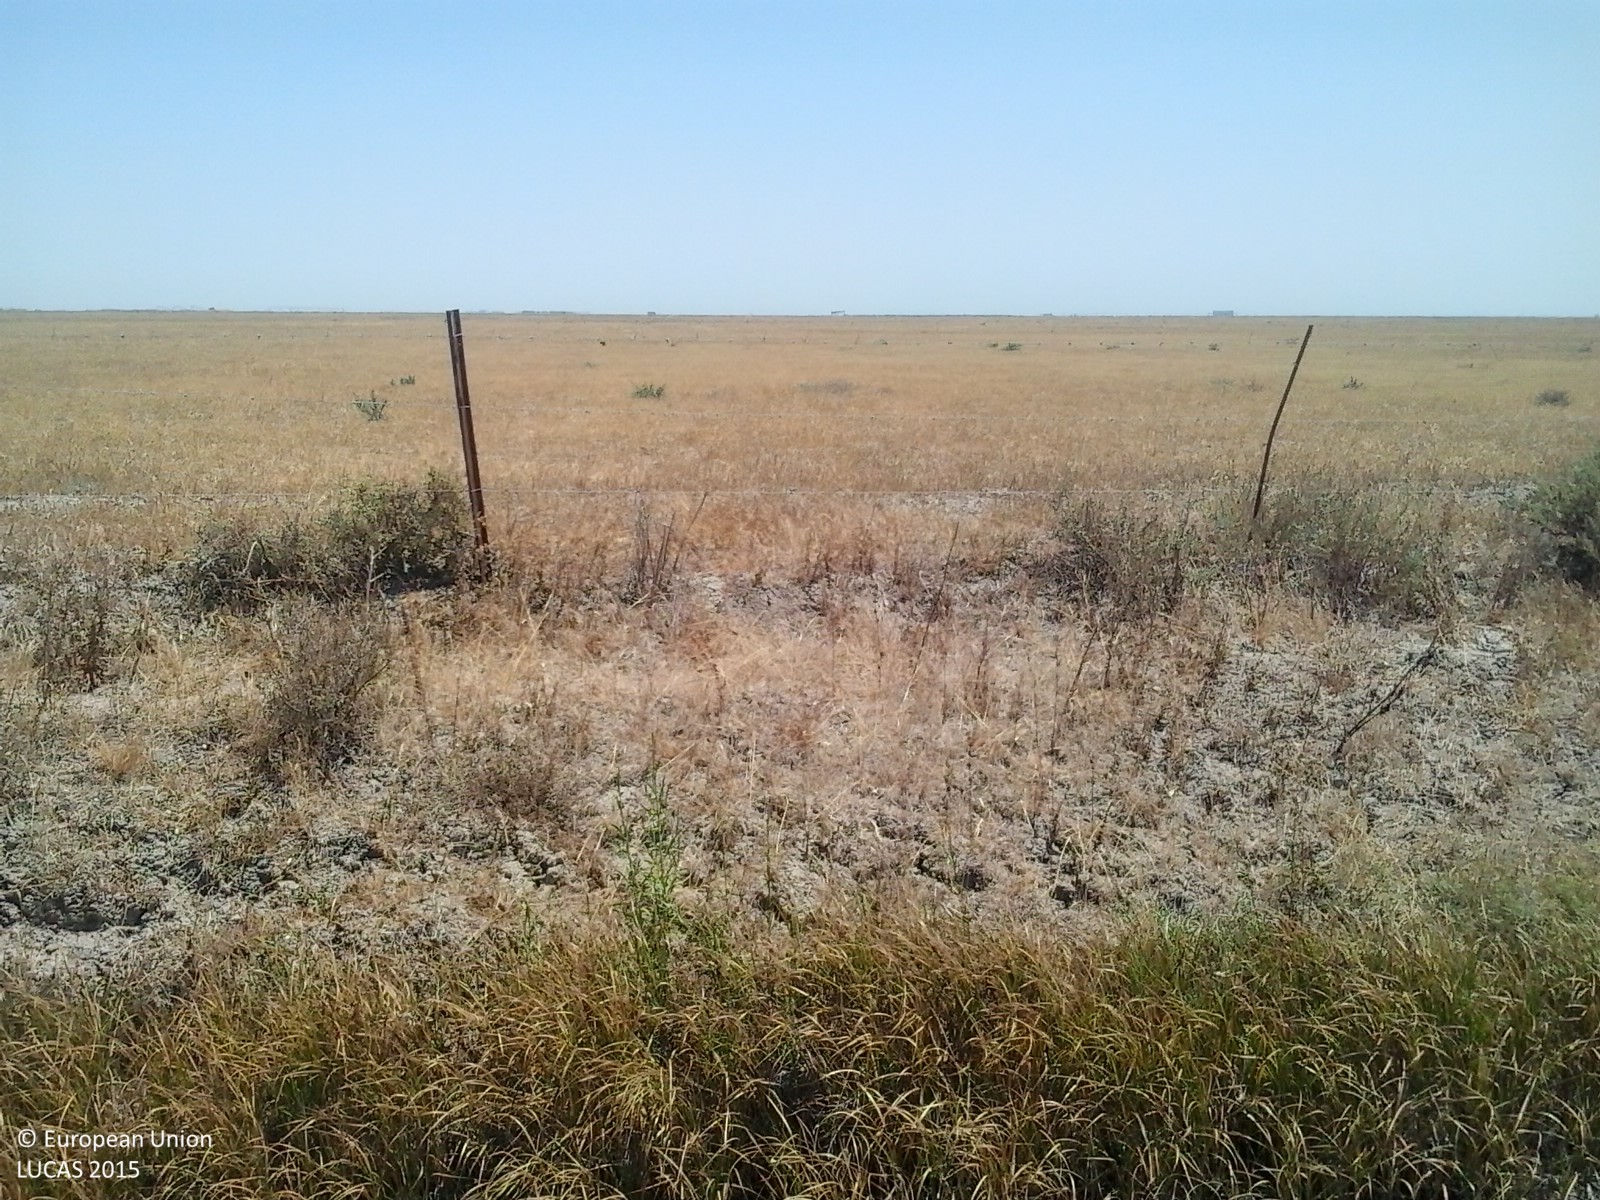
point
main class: Grassland
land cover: Spontaneously vegetated surfaces
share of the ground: > 75 %
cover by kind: herbaceous plants 100 %
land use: Fallow land
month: July
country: ES
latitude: 37.1226
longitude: -6.3100
